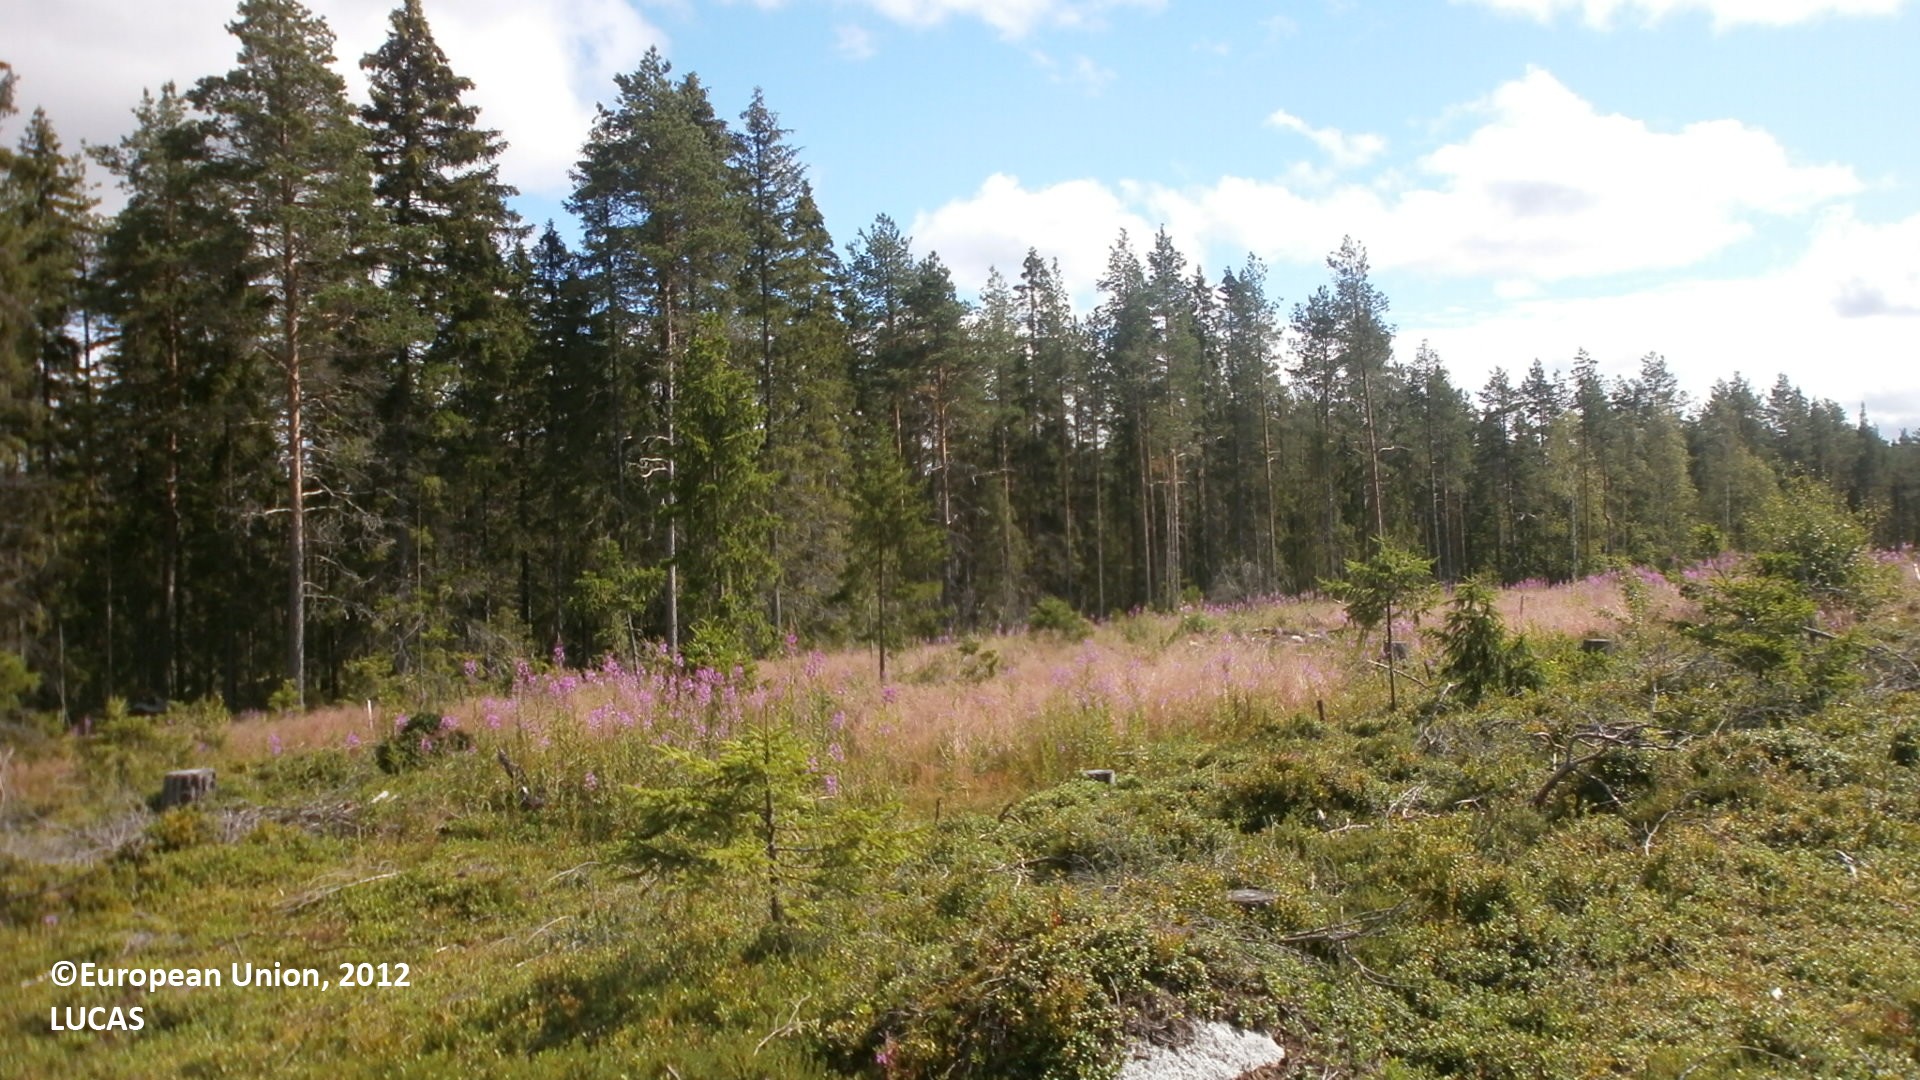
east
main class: Shrubland
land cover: Shrubland without tree cover
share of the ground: > 75 %
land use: Forestry
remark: Clear cut
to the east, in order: Shrubland without tree cover; Spruce dominated coniferous woodland; Pine dominated coniferous woodland; Spruce dominated coniferous woodland; Ditches and canals; Spruce dominated coniferous woodland; Ditches and canals; Spruce dominated mixed woodland; Spruce dominated coniferous woodland
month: July
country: FI
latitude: 64.0204
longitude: 23.7075
